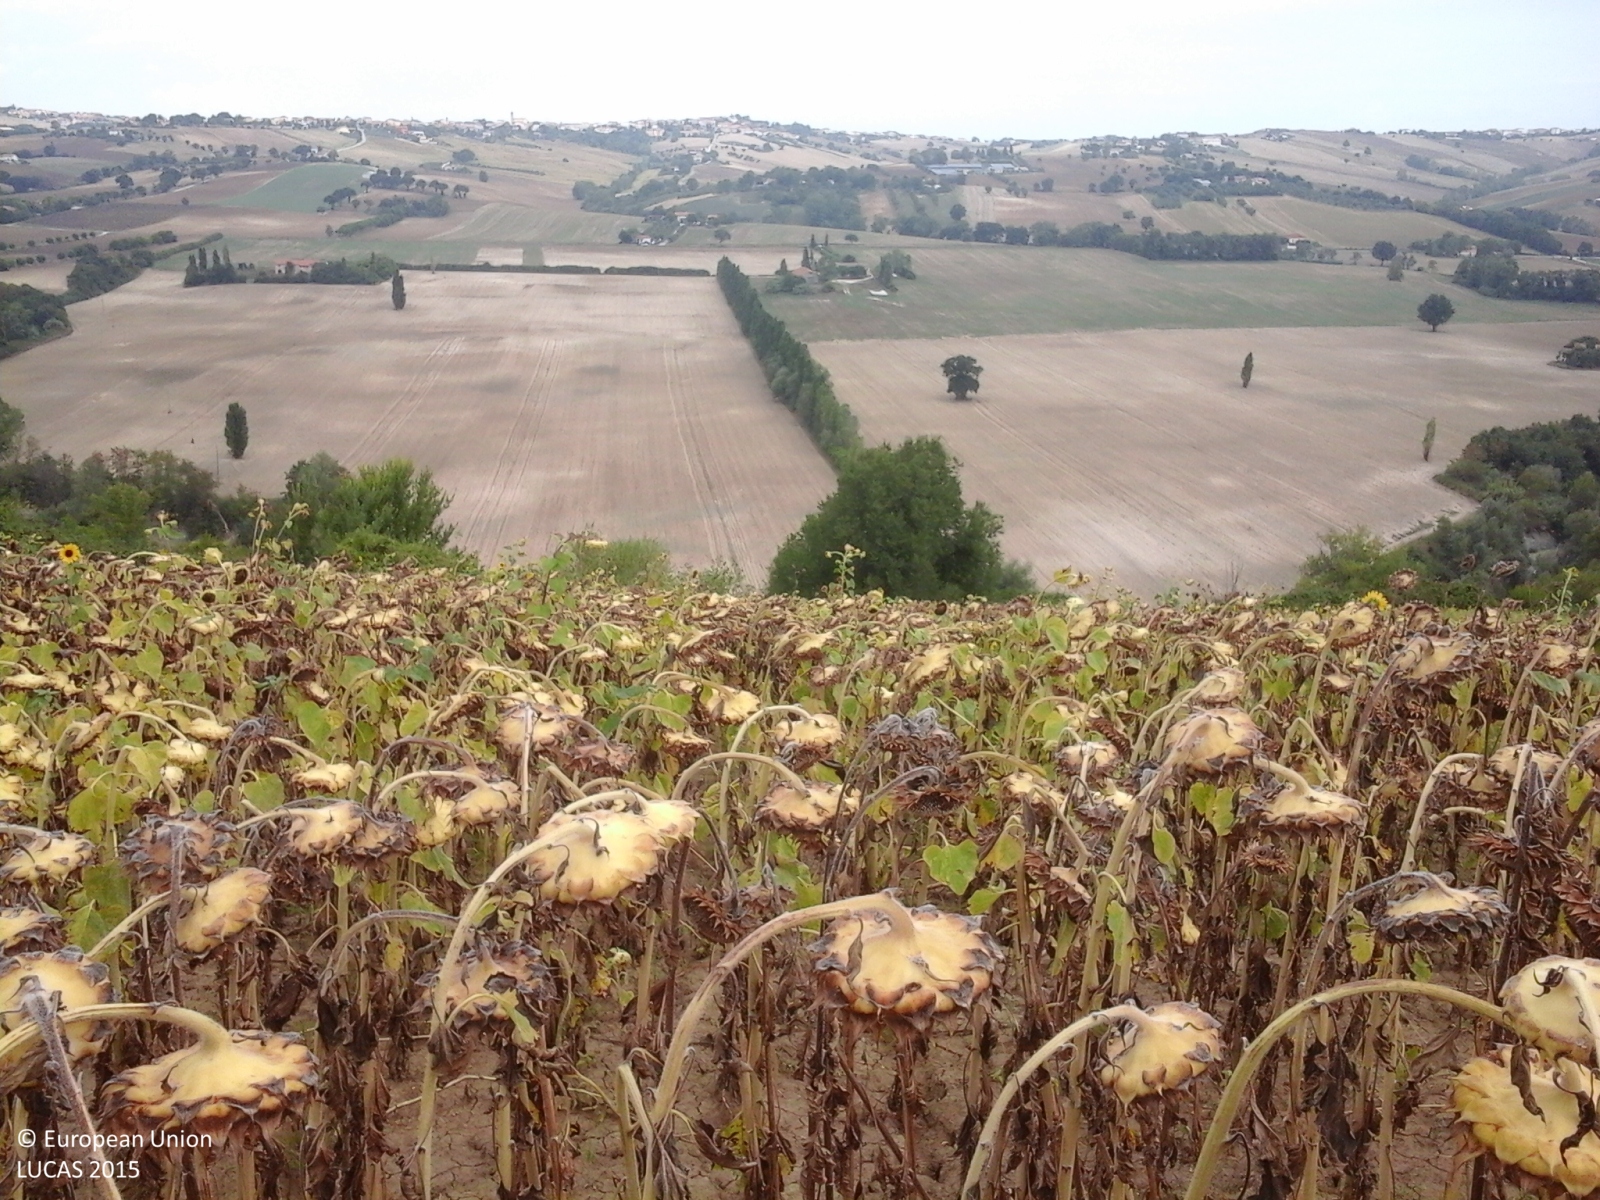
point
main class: Cropland
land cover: Sunflower
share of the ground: > 75 %
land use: Agriculture (excluding fallow land and kitchen gardens)
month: August
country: IT
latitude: 43.4662
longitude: 13.3414
